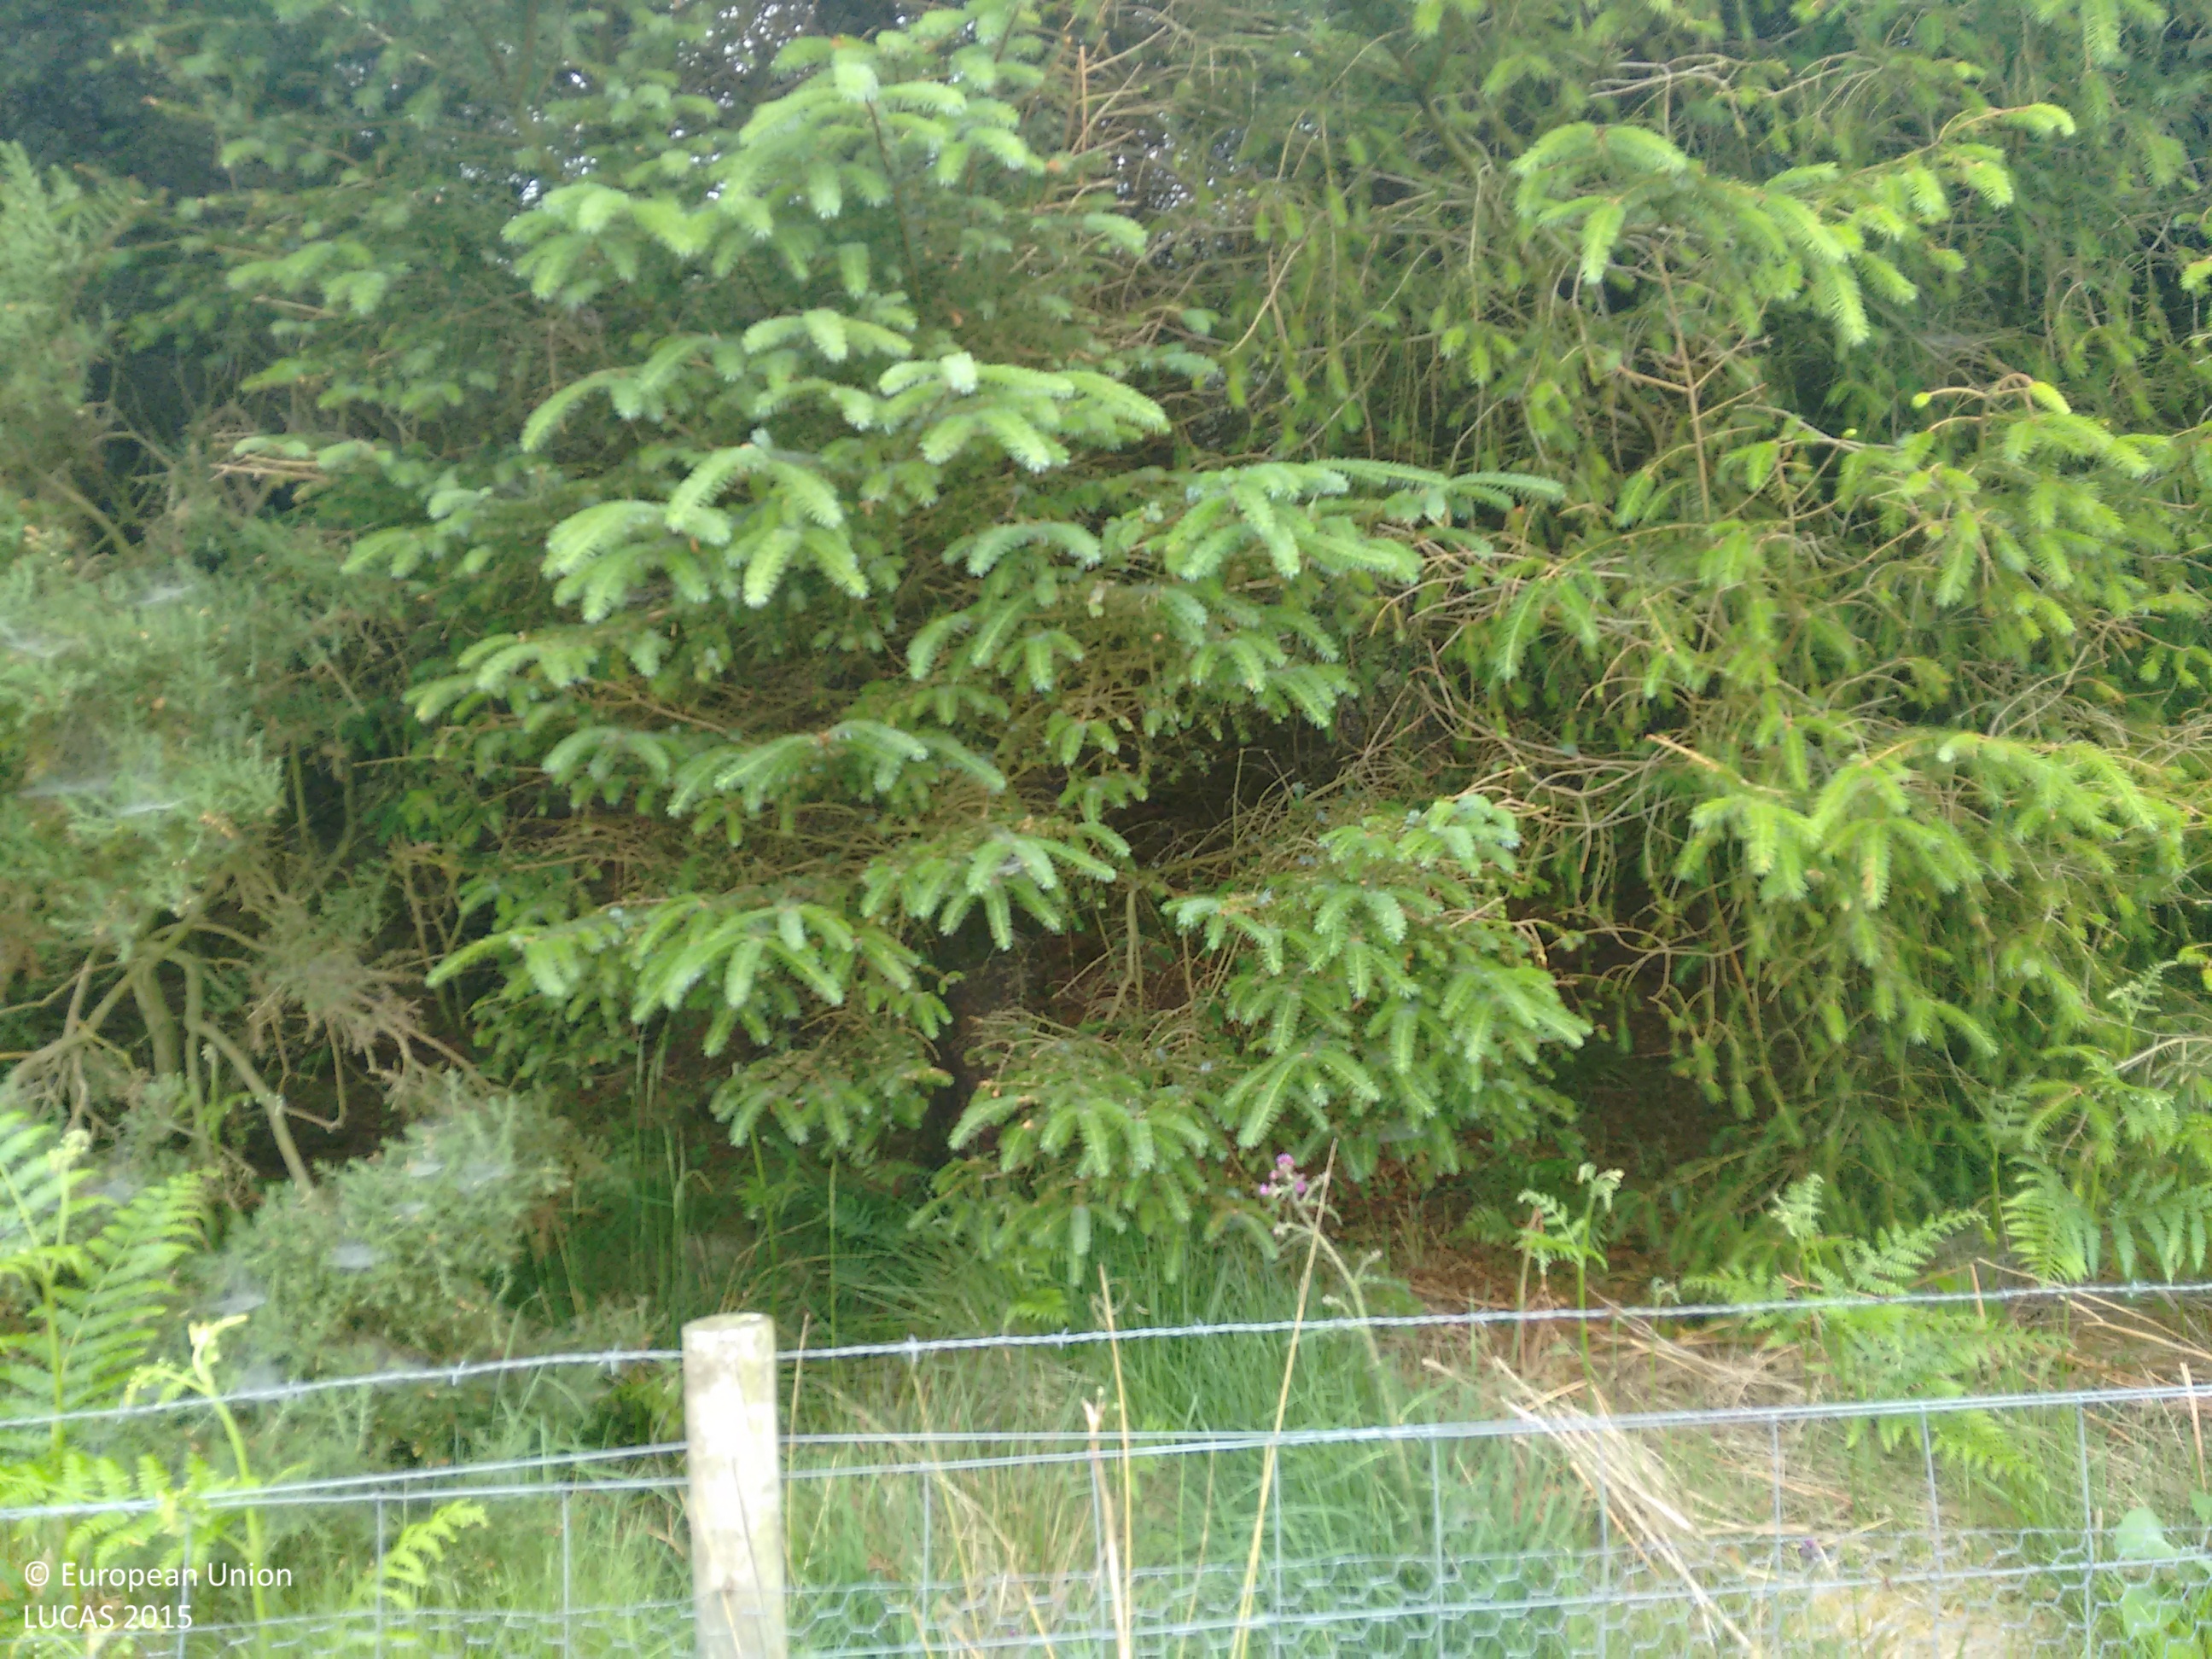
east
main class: Woodland
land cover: Spruce dominated coniferous woodland
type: exotic forest
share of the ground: > 75 %
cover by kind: coniferous forest trees 100 %
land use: Forestry
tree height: > 5 m
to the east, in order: Spruce dominated coniferous woodland
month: July
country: GB
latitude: 54.9214
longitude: -3.6740
